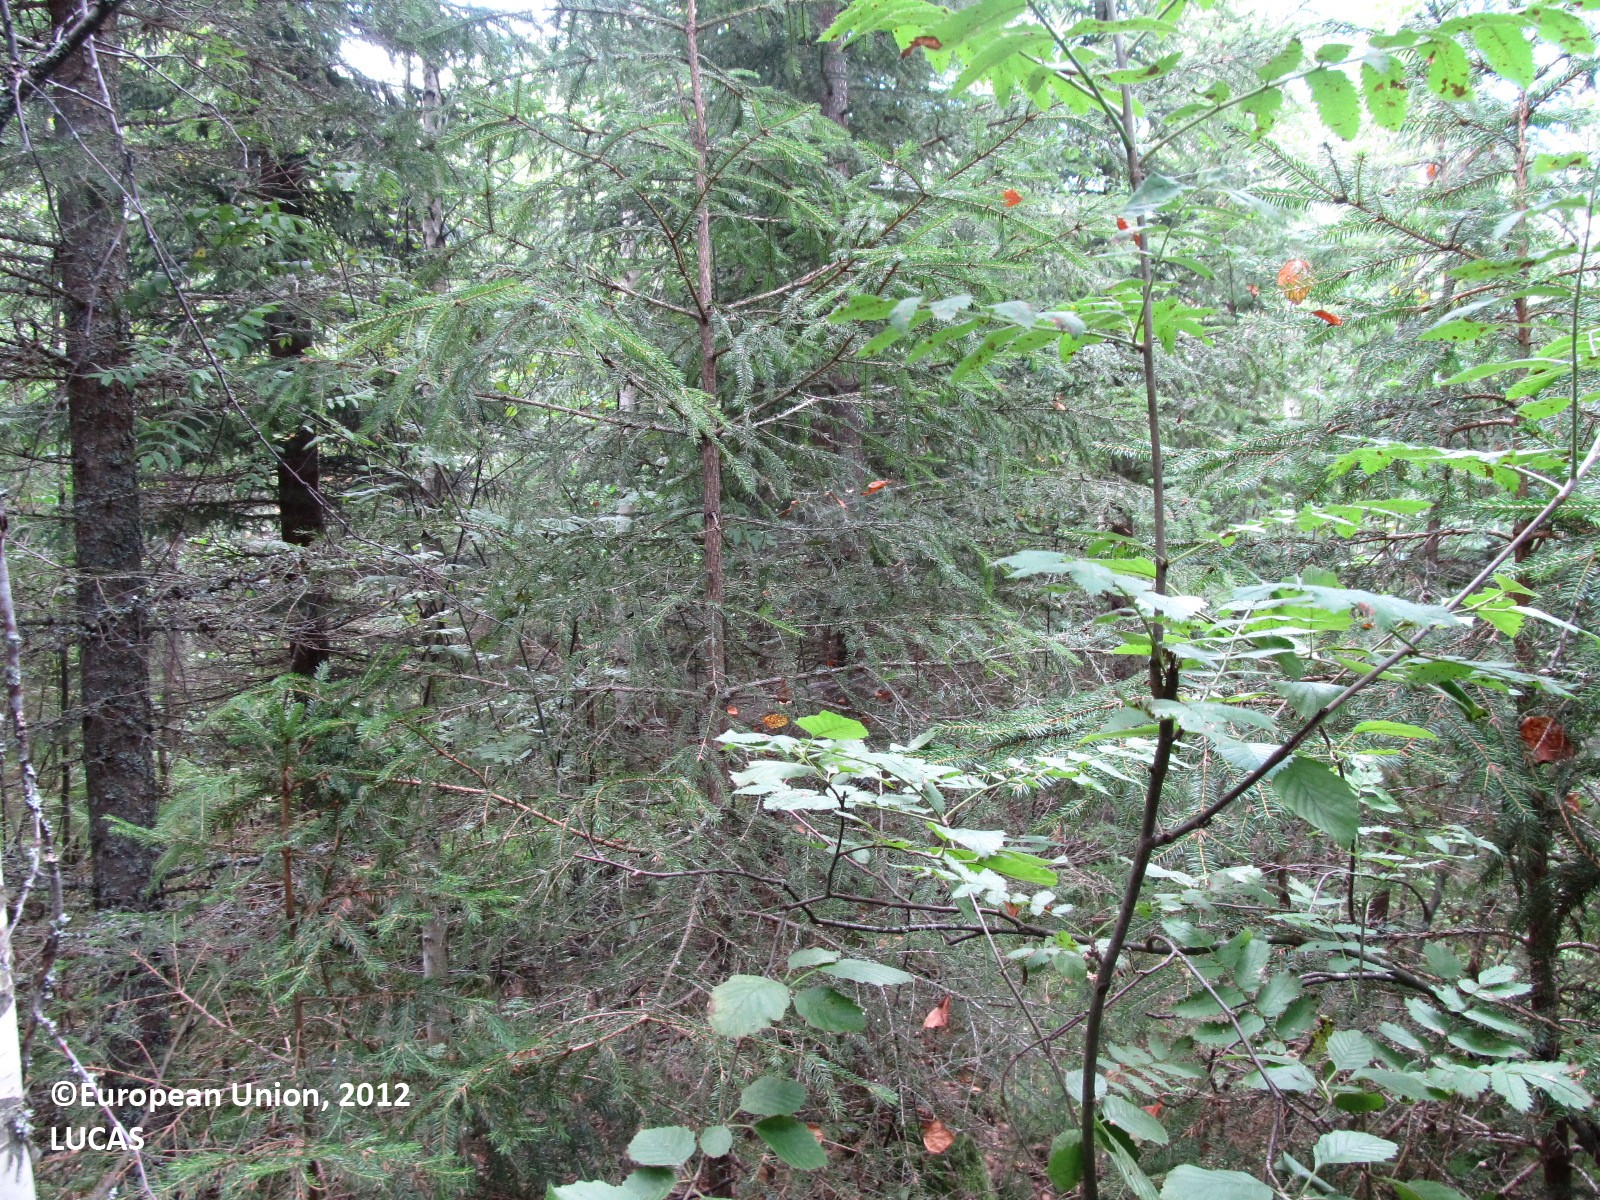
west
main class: Woodland
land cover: Spruce dominated mixed woodland
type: boreal forest
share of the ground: 50 - 75 %
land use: Forestry
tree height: > 5 m
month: August
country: FI
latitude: 61.8186
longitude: 27.7790
